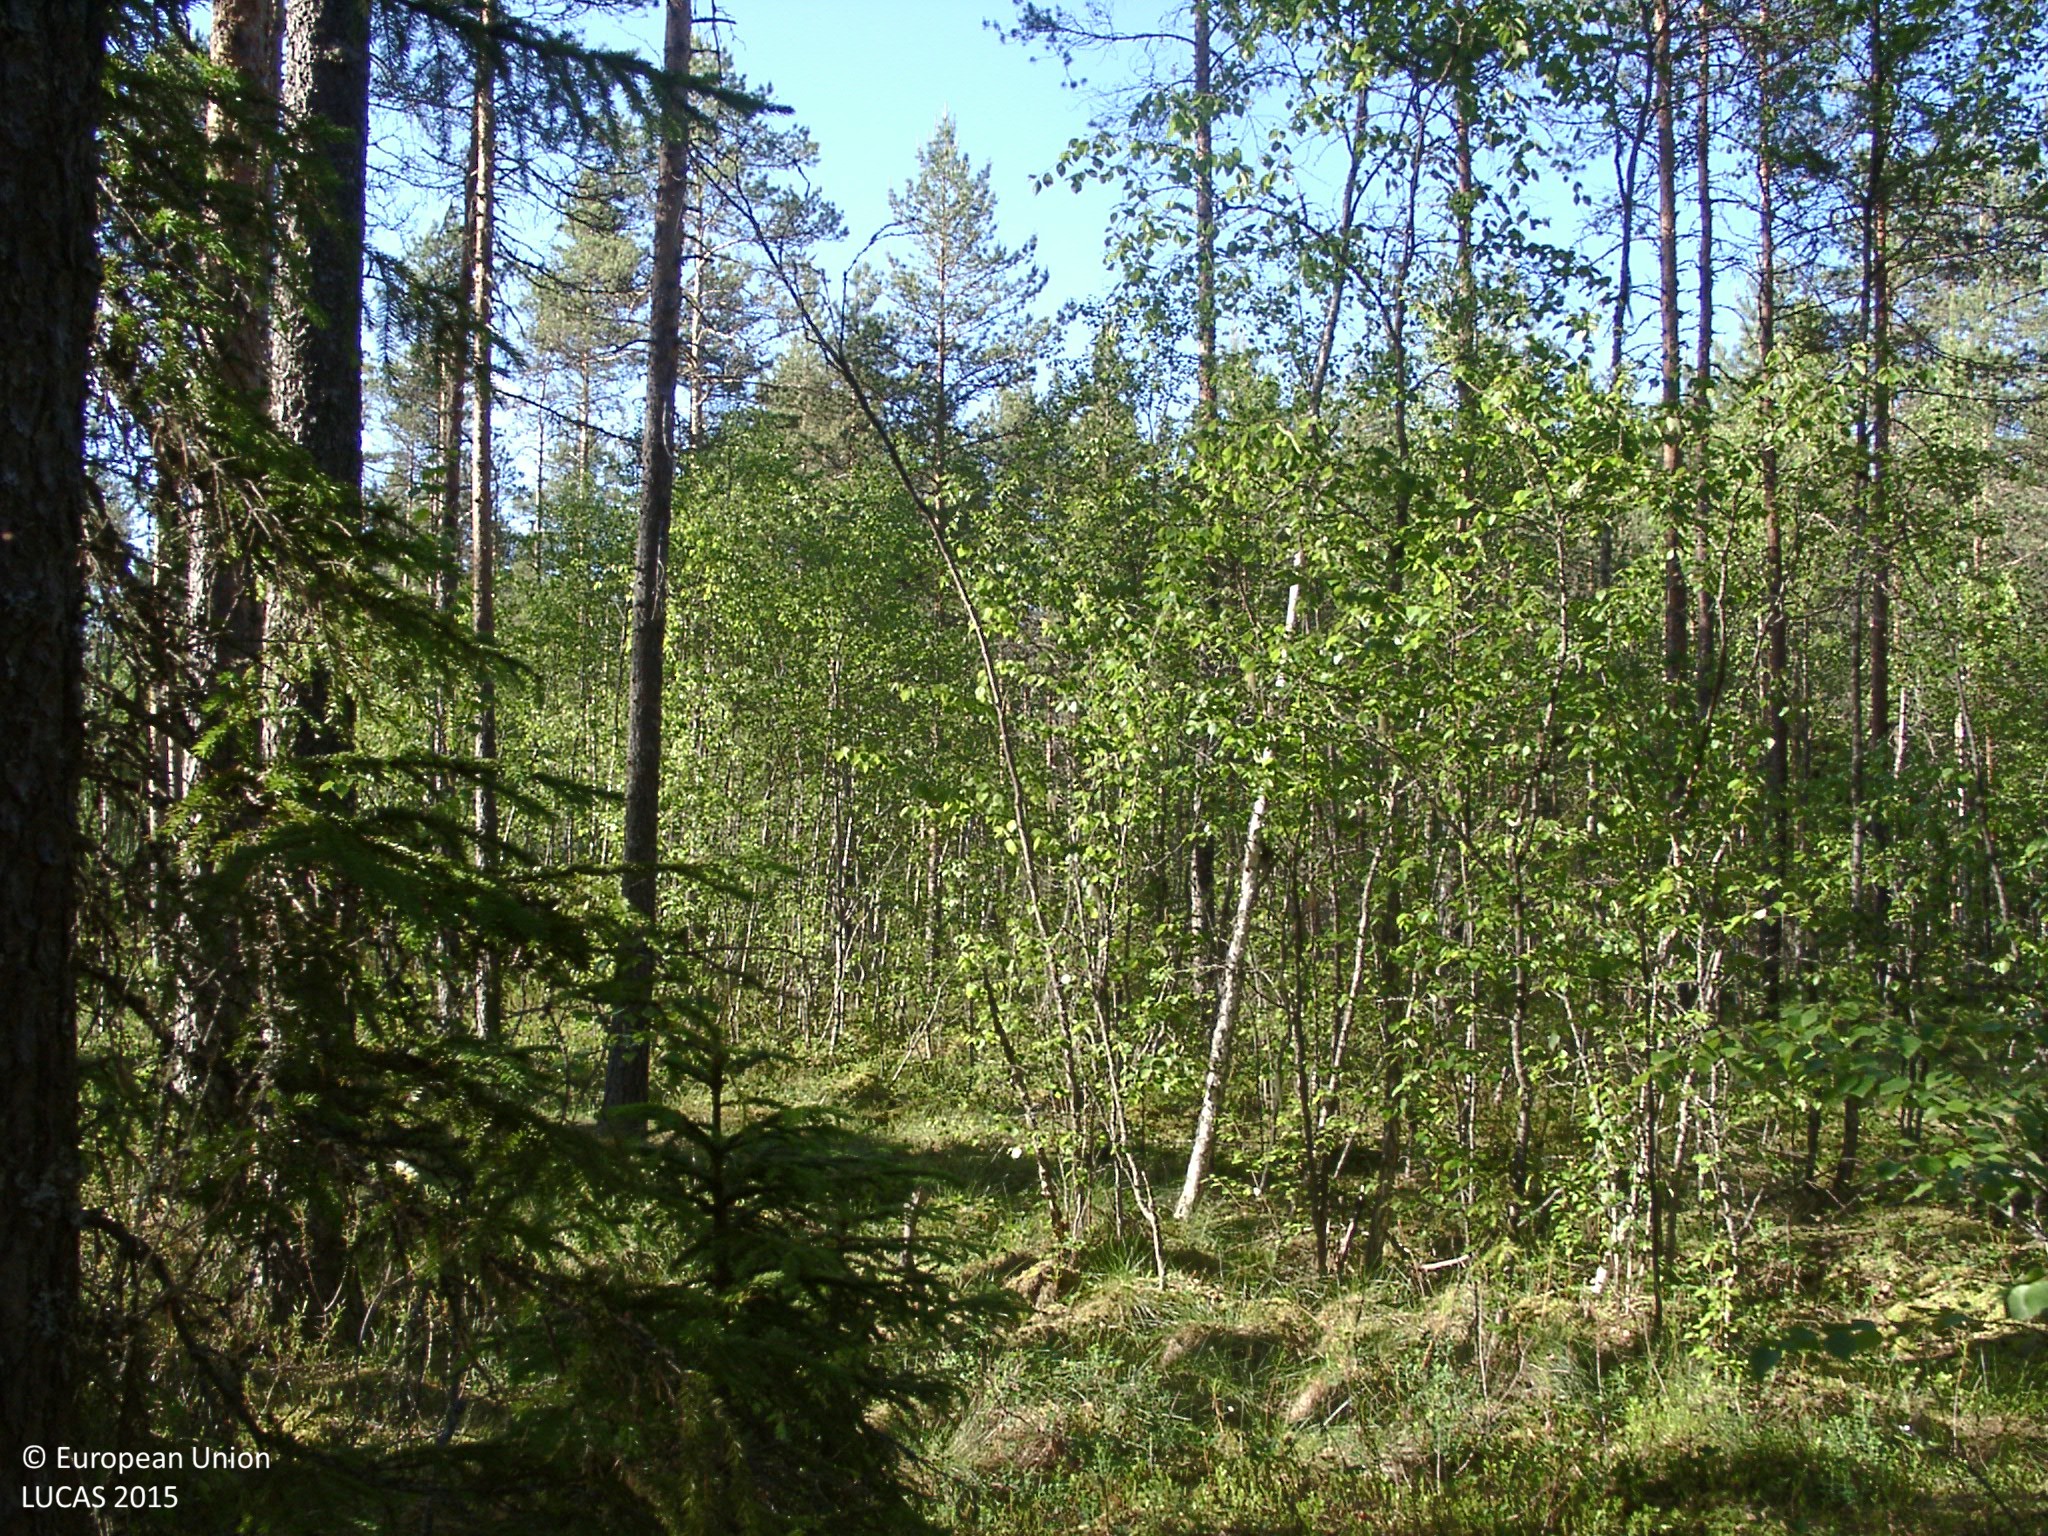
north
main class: Woodland
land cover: Pine dominated coniferous woodland
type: mire and swamp forests
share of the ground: 50 - 75 %
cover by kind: coniferous forest trees 55 %, shrubs 20 %, broadleaved forest trees 10 %, lichens and mosses 10 %, herbaceous plants 5 %
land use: Semi-natural and natural areas not in use
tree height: > 5 m
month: June
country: FI
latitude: 62.1419
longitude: 24.8914
